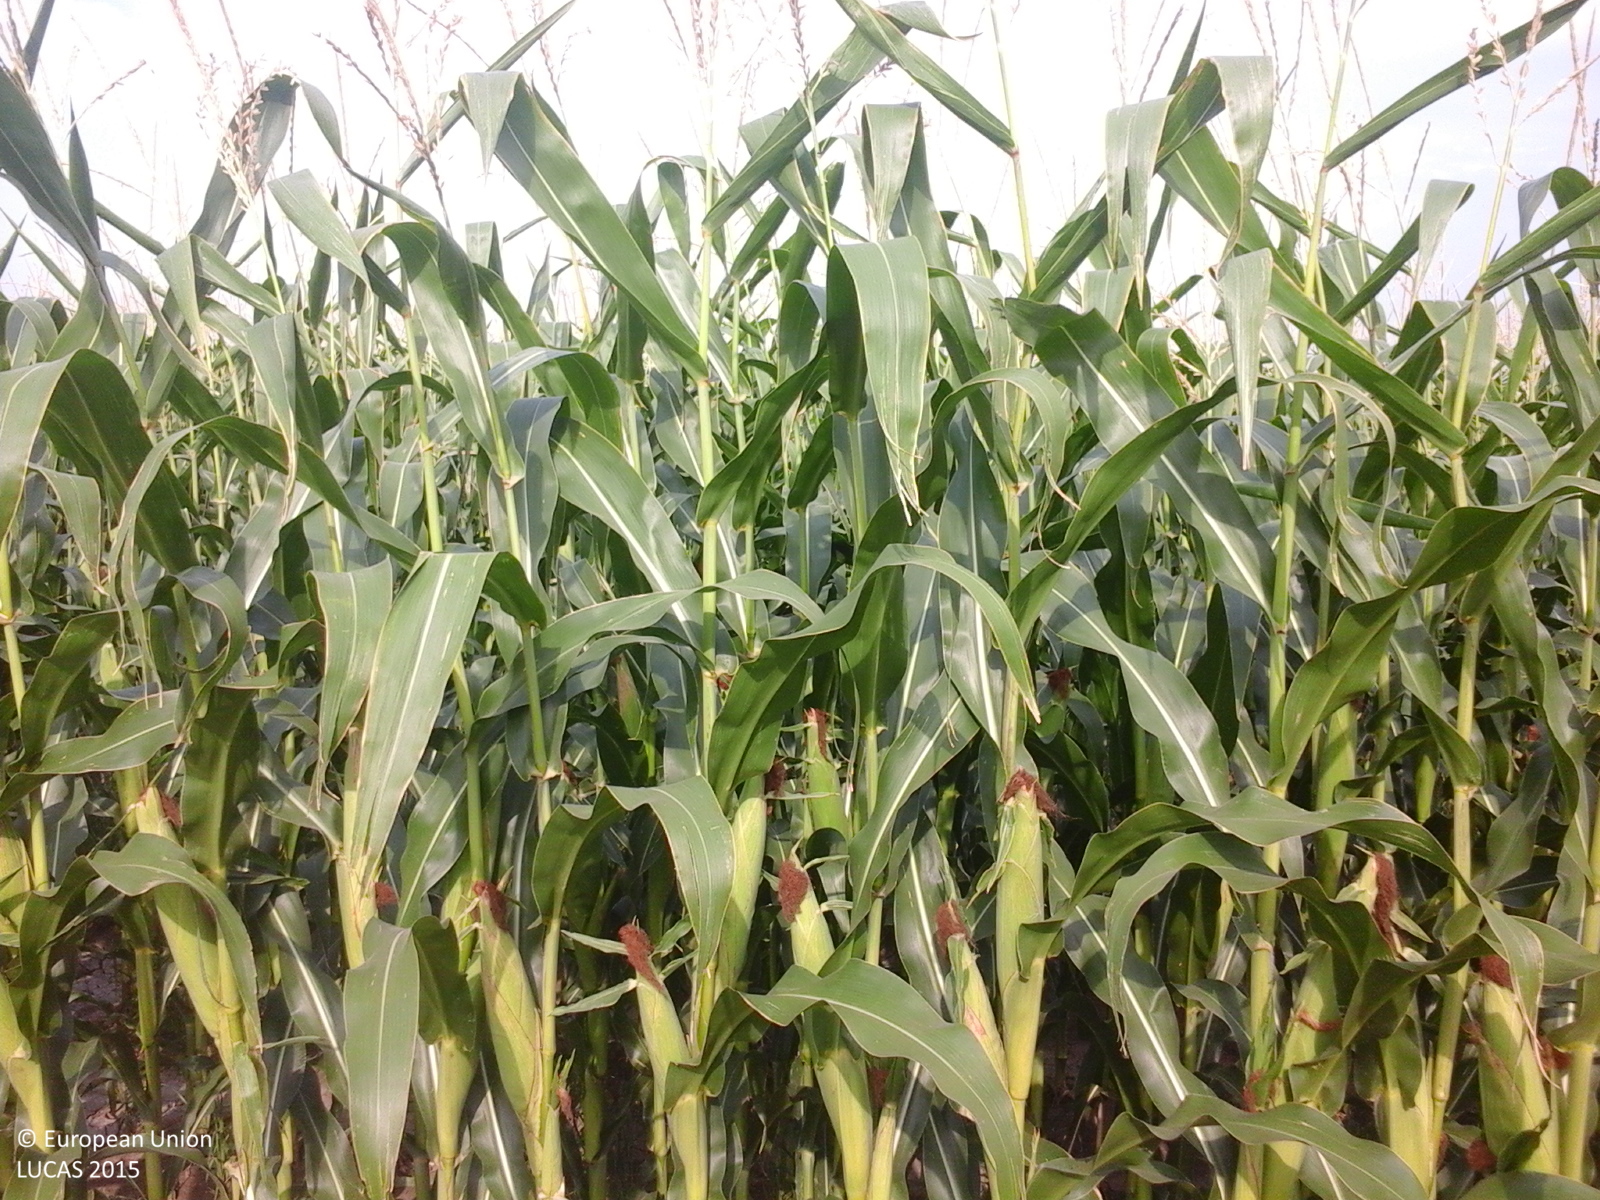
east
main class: Cropland
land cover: Maize
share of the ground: > 75 %
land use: Agriculture (excluding fallow land and kitchen gardens)
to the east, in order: Maize
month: August
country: RO
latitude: 45.0504
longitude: 27.6629
